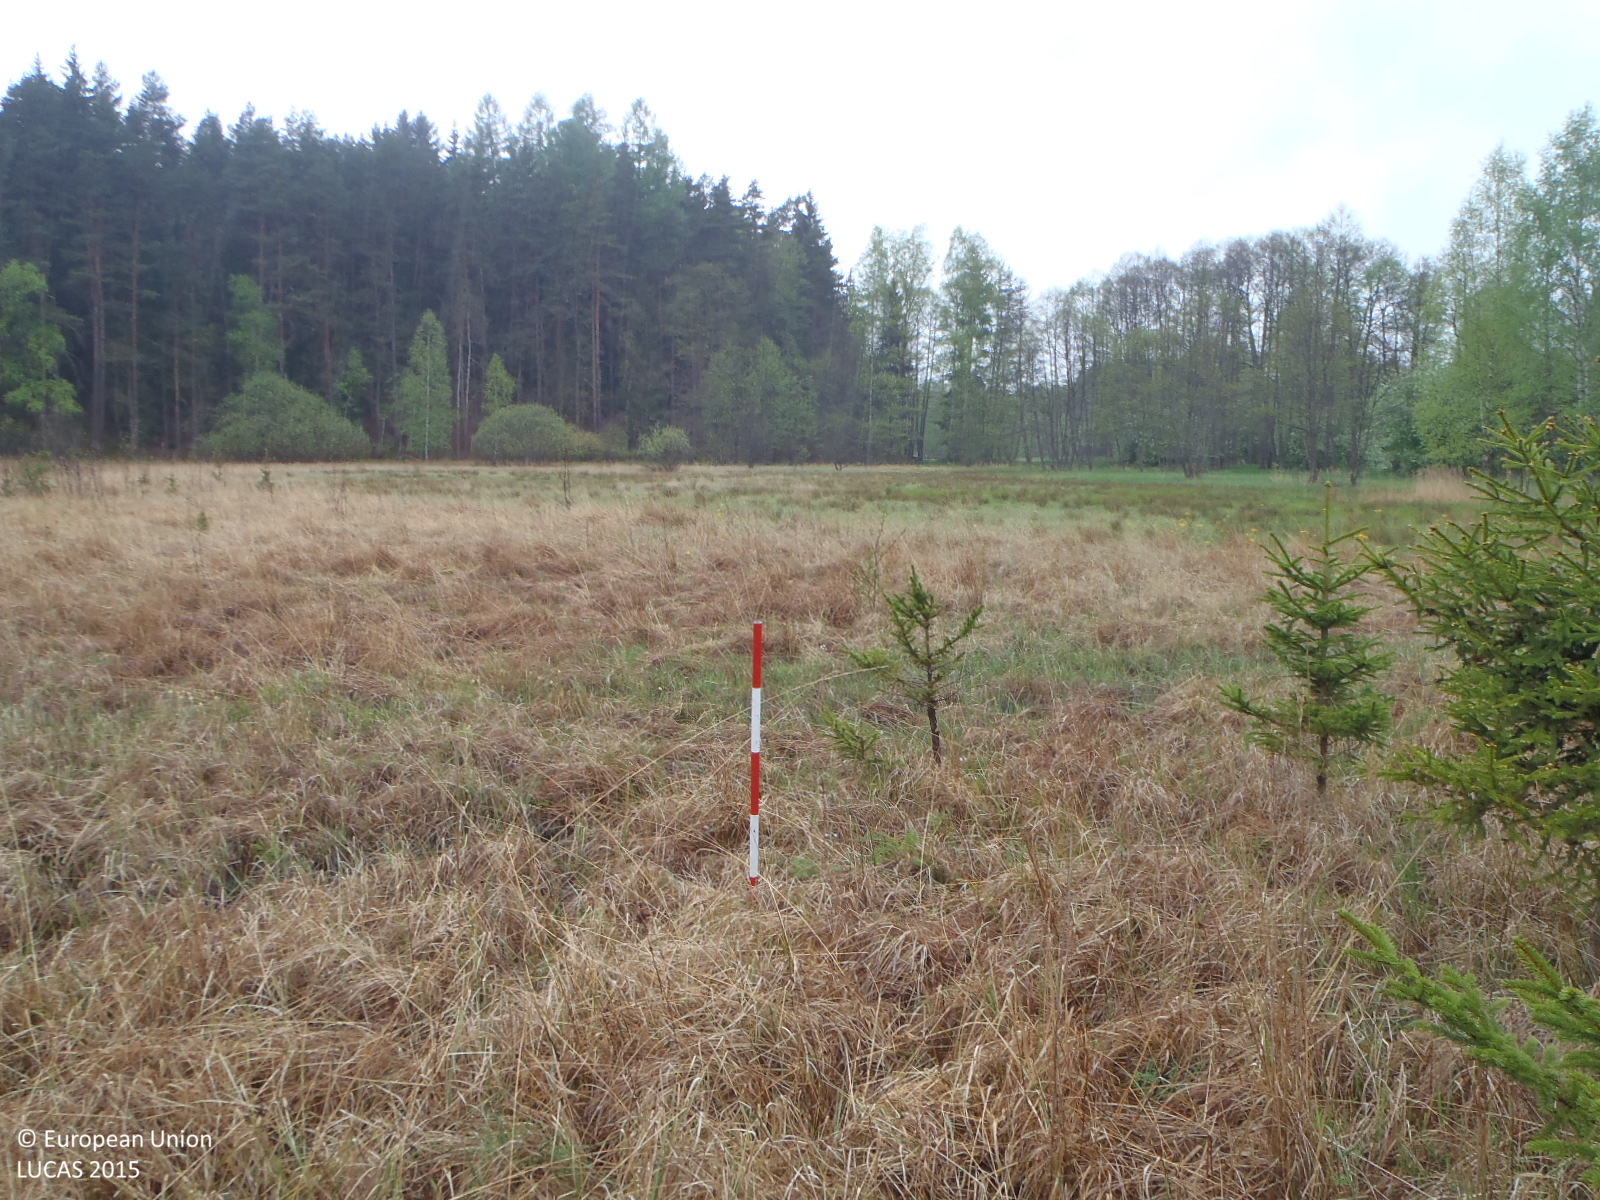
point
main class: Woodland
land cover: Spruce dominated coniferous woodland
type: mire and swamp forests
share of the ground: 25 - 50 %
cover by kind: herbaceous plants 70 %, coniferous forest trees 25 %, broadleaved forest trees 5 %
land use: Abandoned areas
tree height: > 5 m
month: May
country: CZ
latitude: 49.2067
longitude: 15.0673
